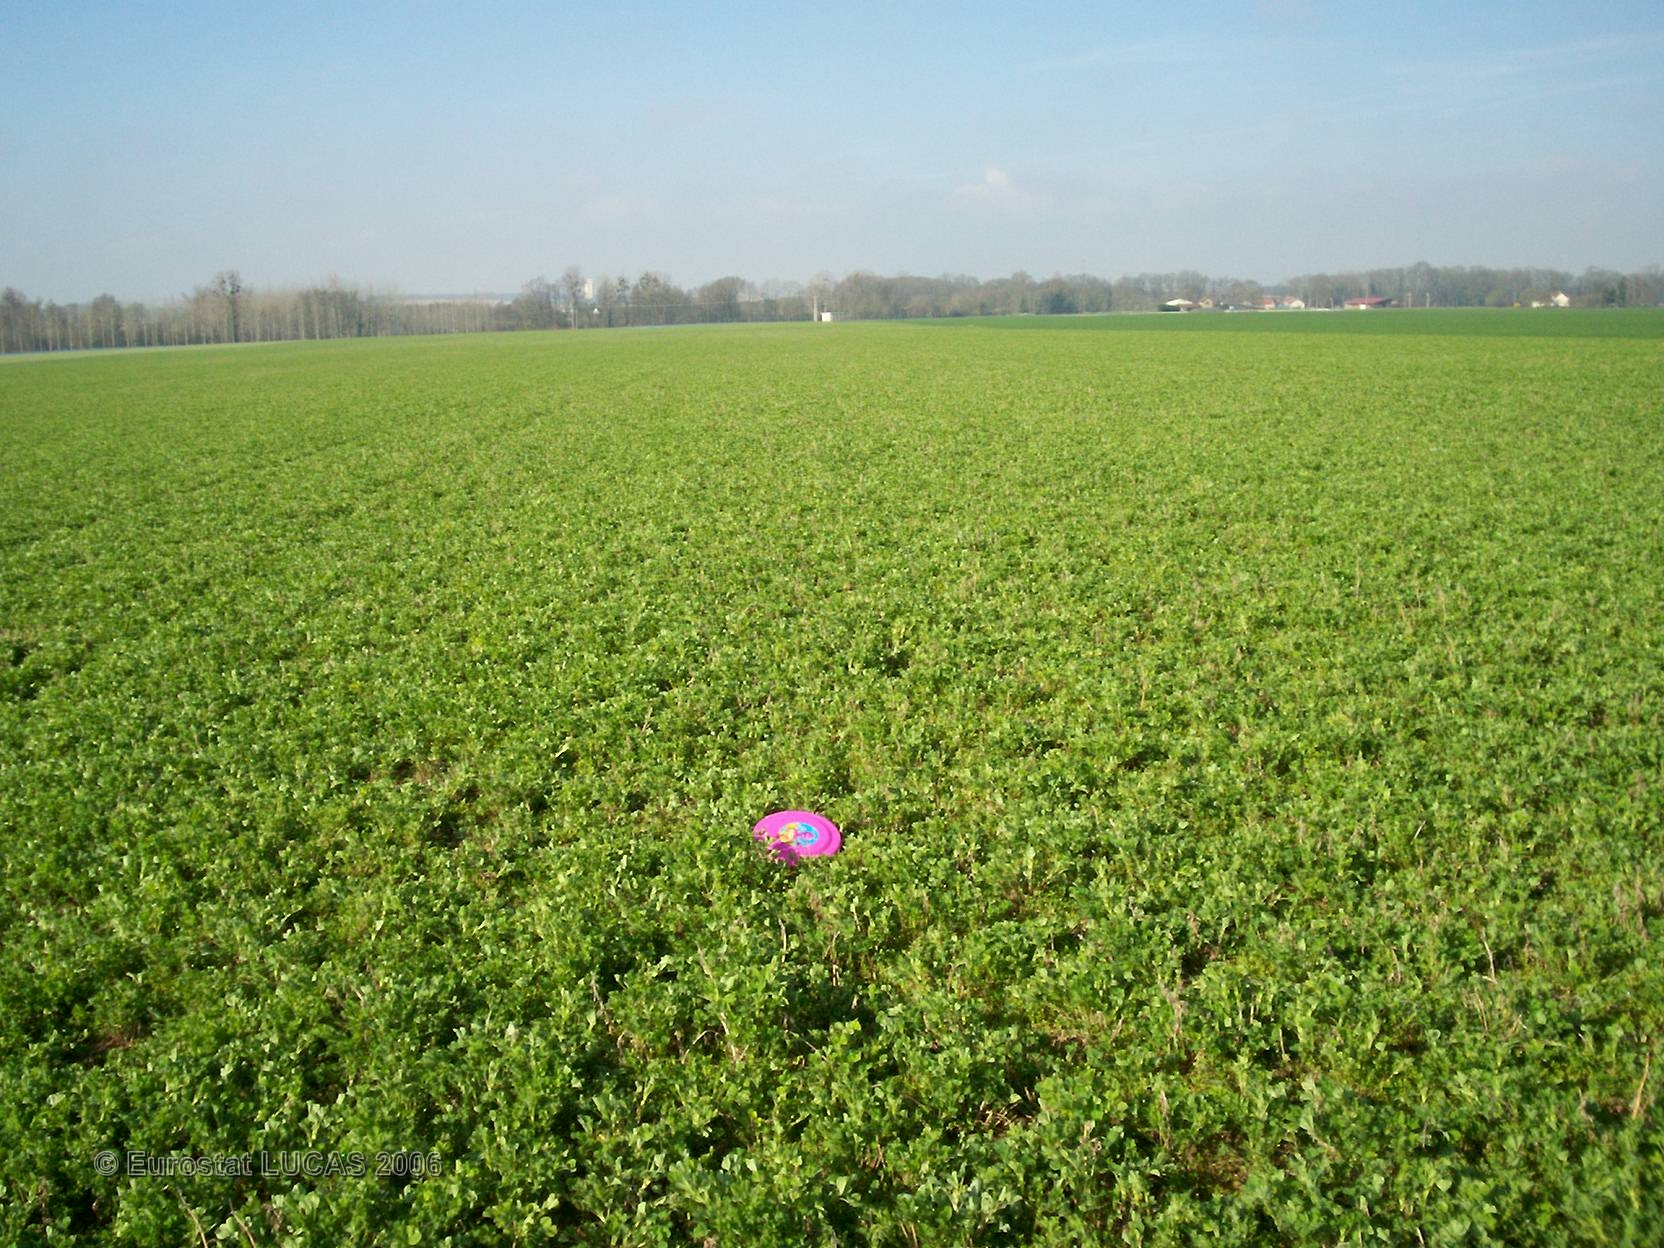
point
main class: Cropland
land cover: Lucerne
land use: Agriculture (excluding fallow land and kitchen gardens)
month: April
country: FR
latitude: 49.0896
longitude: 4.3682
